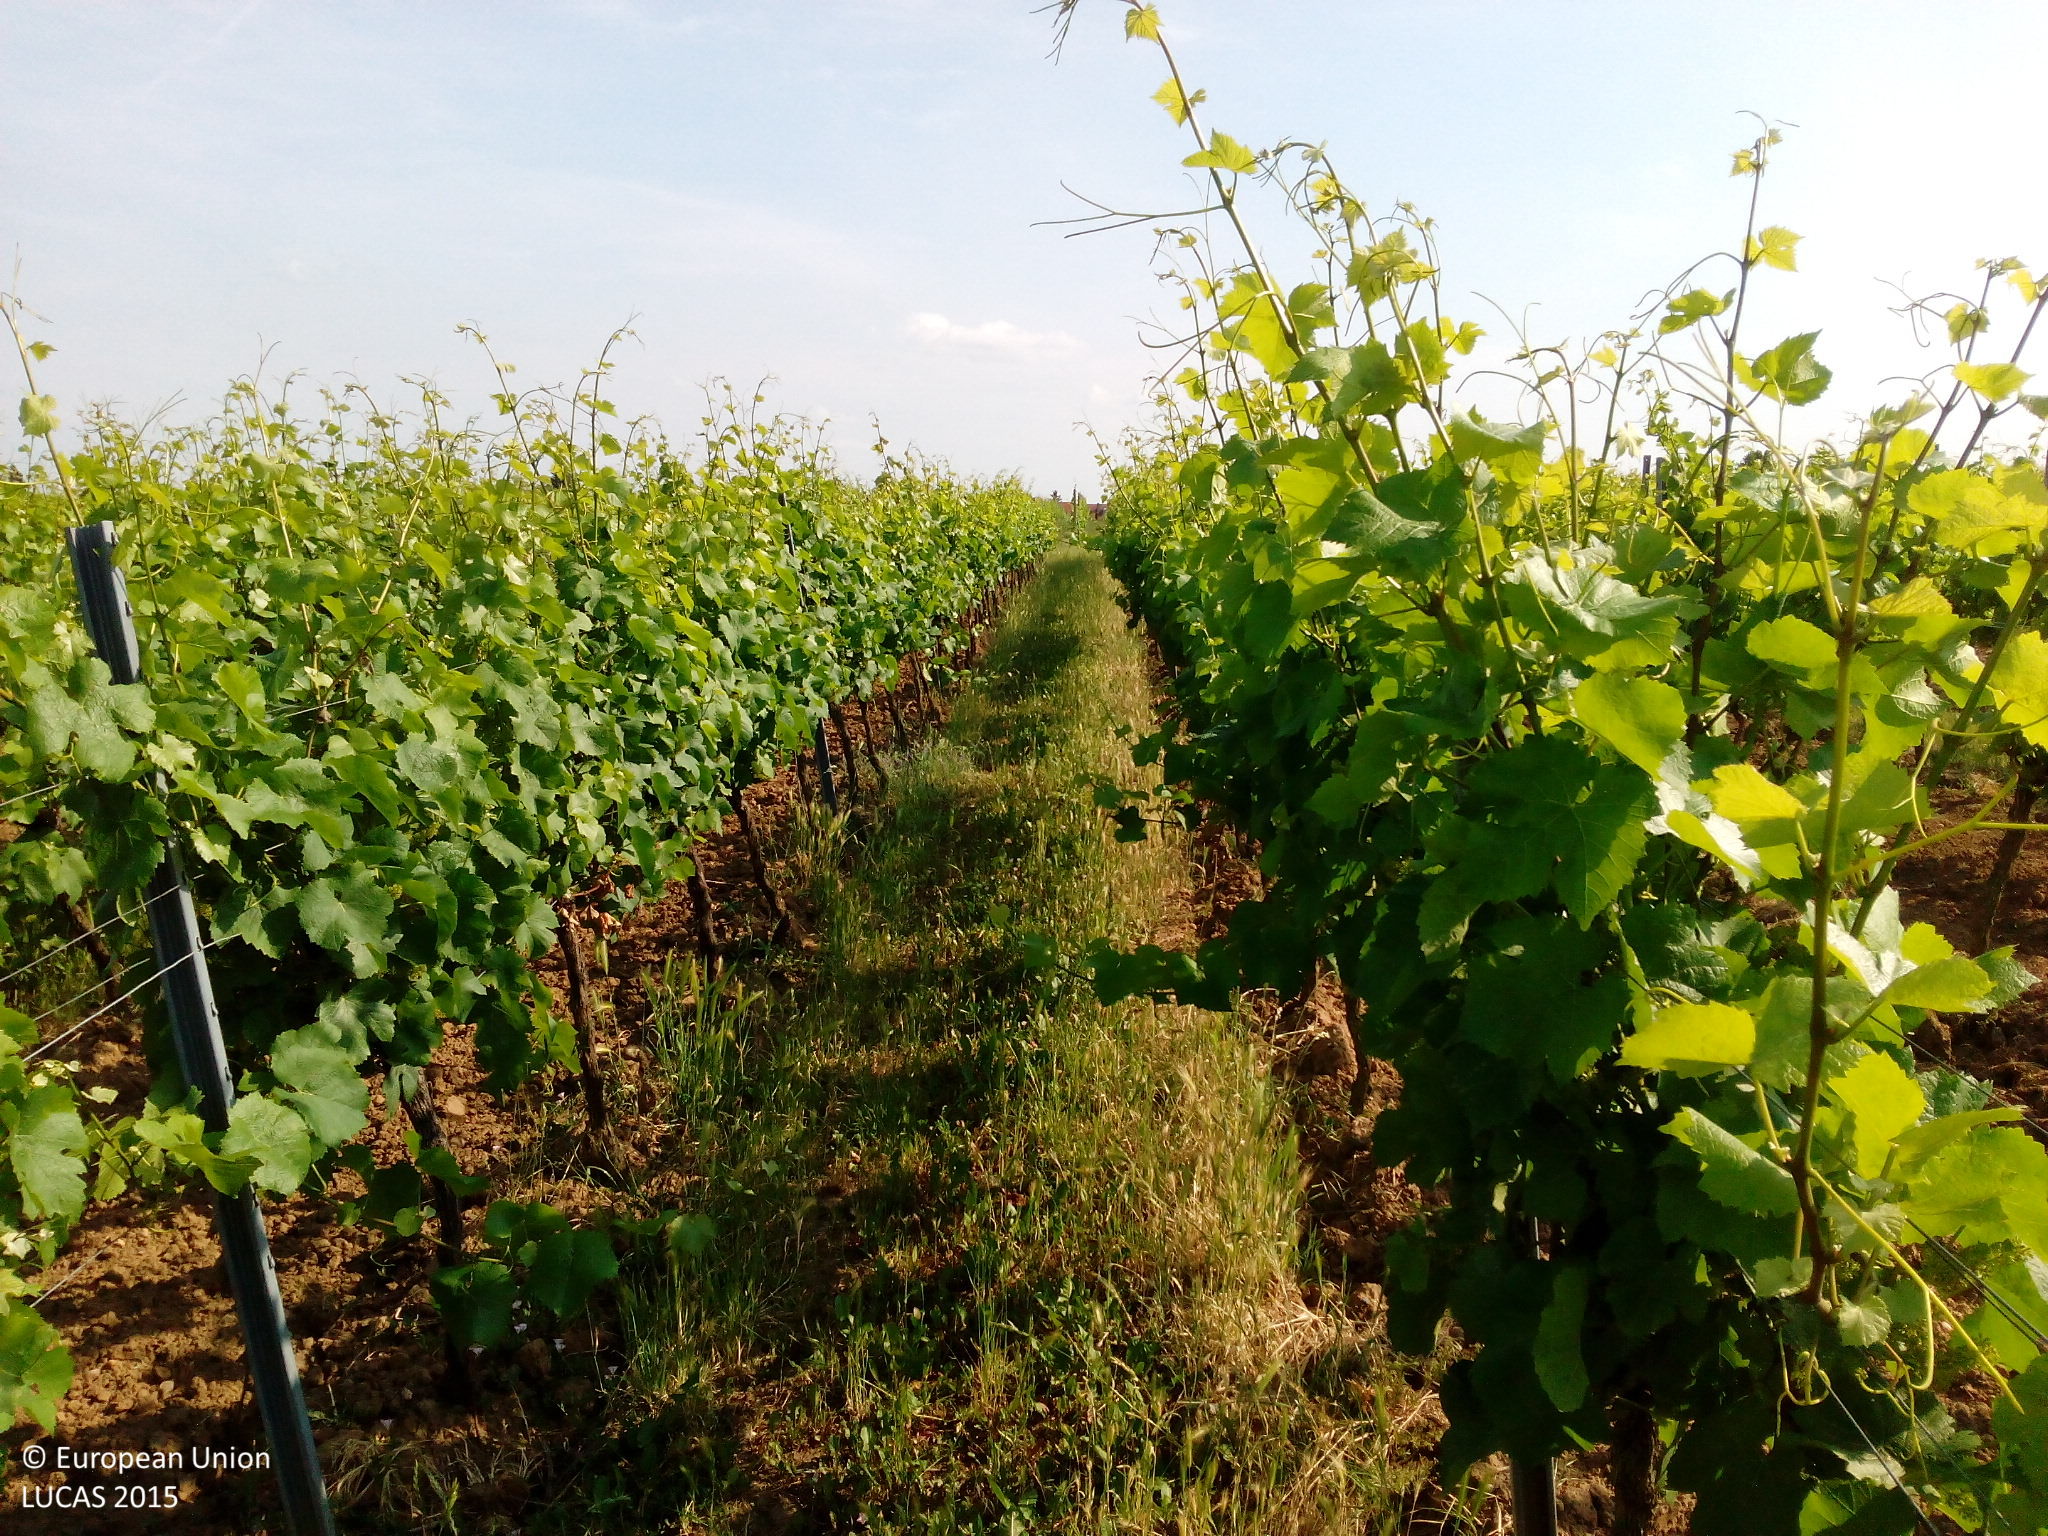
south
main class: Cropland
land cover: Vineyards
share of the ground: 10 - 25 %
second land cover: Grassland without tree/shrub cover
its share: 25 - 50 %
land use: Agriculture (excluding fallow land and kitchen gardens)
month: June
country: DE
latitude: 49.3780
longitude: 8.1686
